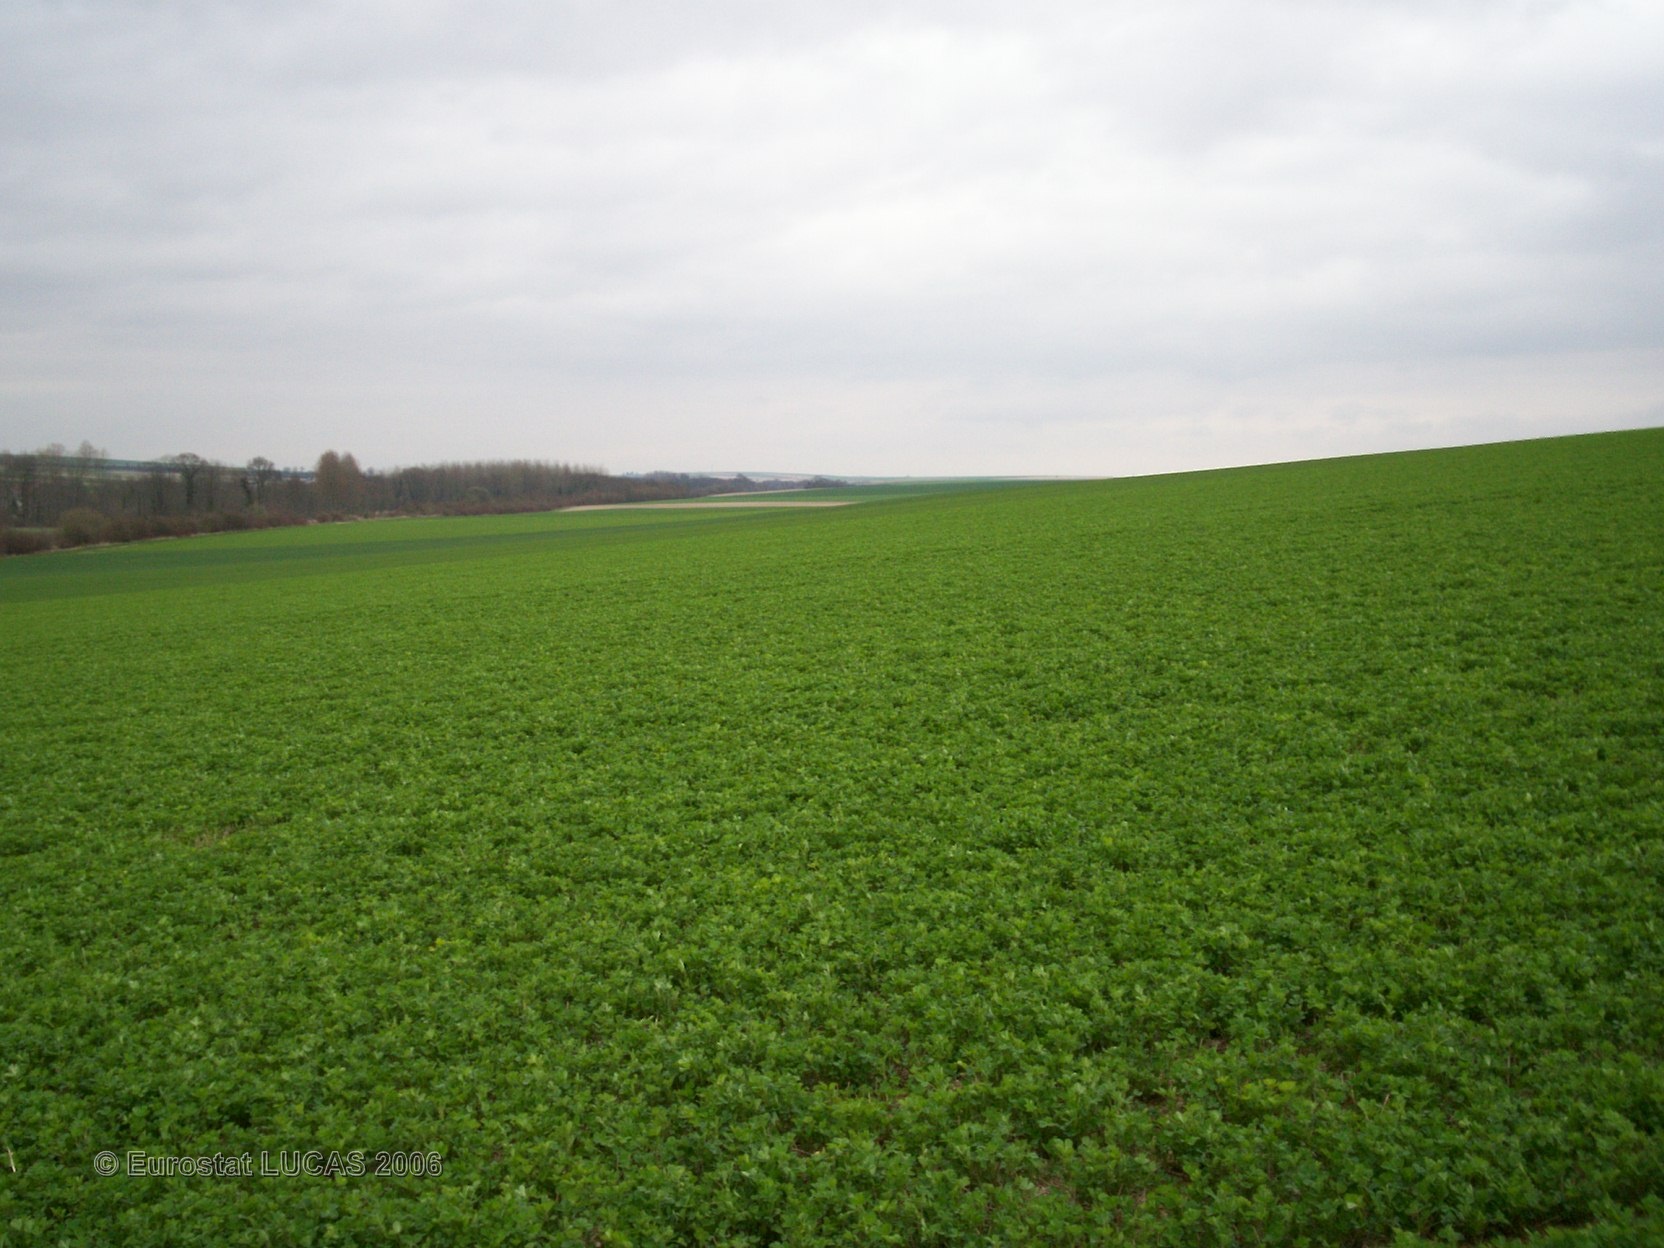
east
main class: Cropland
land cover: Lucerne
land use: Agriculture (excluding fallow land and kitchen gardens)
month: April
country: FR
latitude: 49.2371
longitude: 4.4339
